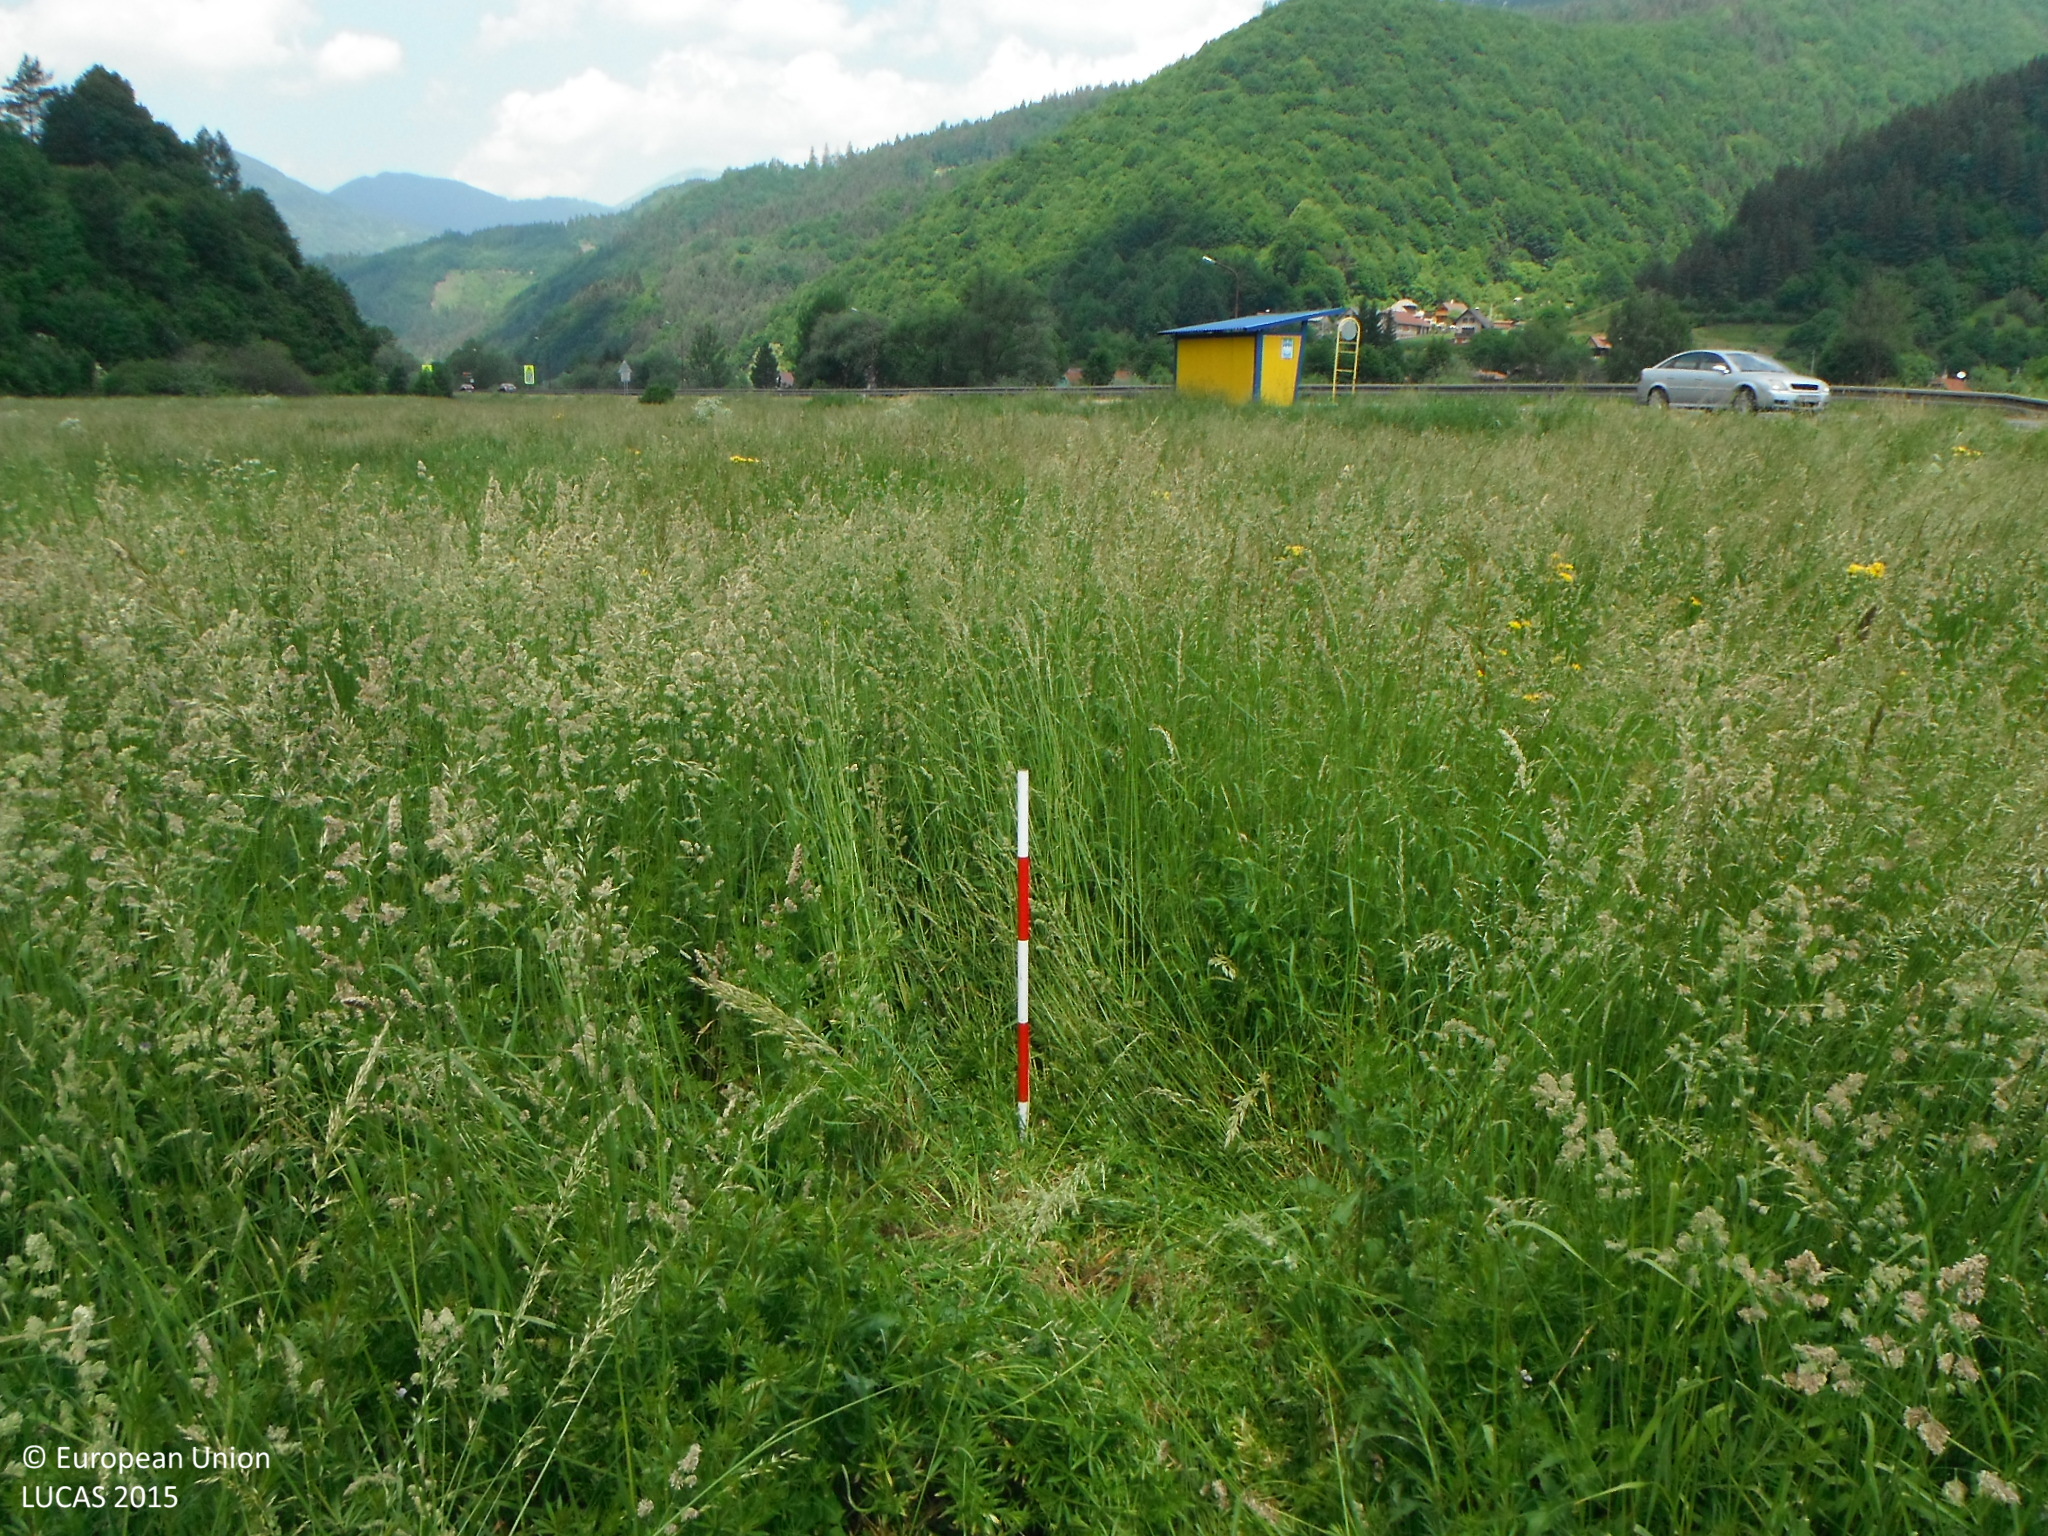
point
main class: Grassland
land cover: Grassland without tree/shrub cover
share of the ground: > 75 %
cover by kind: herbaceous plants 100 %
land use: Agriculture (excluding fallow land and kitchen gardens)
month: June
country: SK
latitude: 49.1445
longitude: 19.1669
